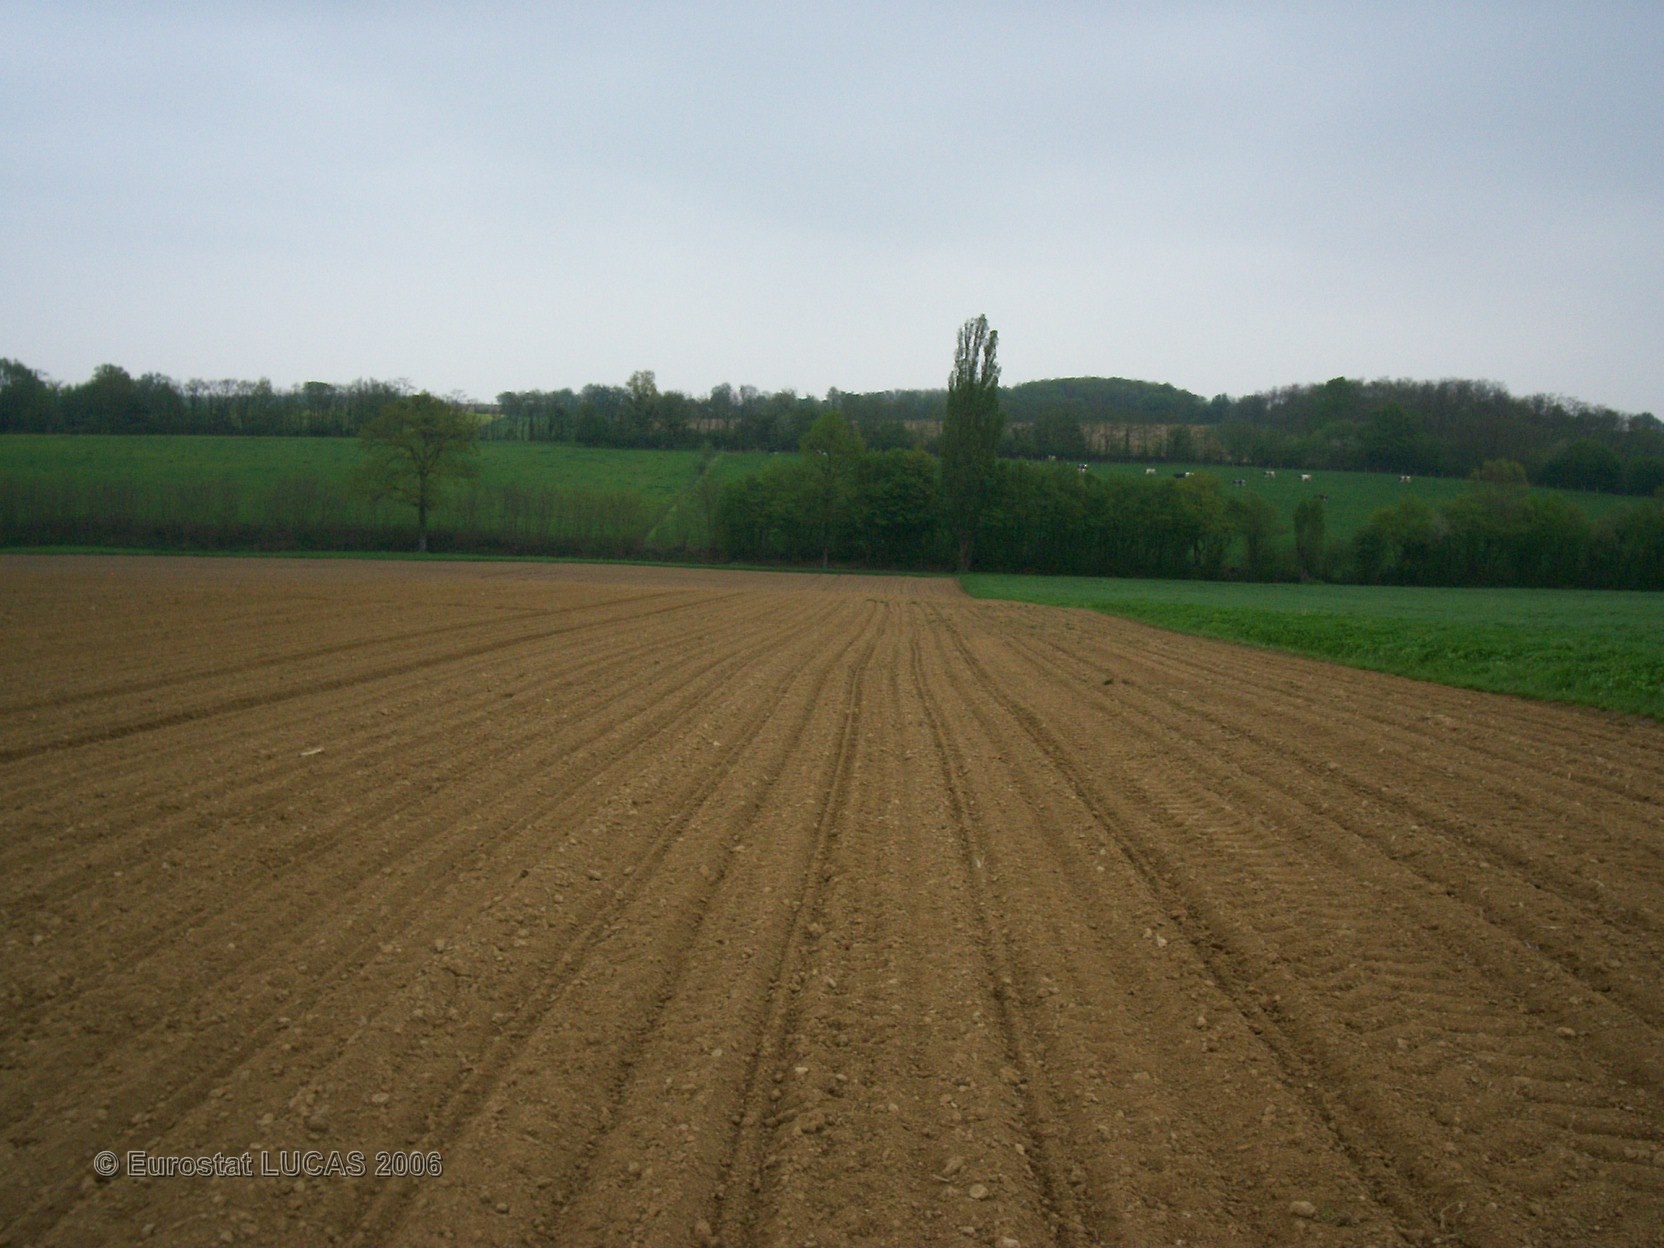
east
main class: Cropland
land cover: Maize
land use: Agriculture (excluding fallow land and kitchen gardens)
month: April
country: FR
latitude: 46.1196
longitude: 4.8654
